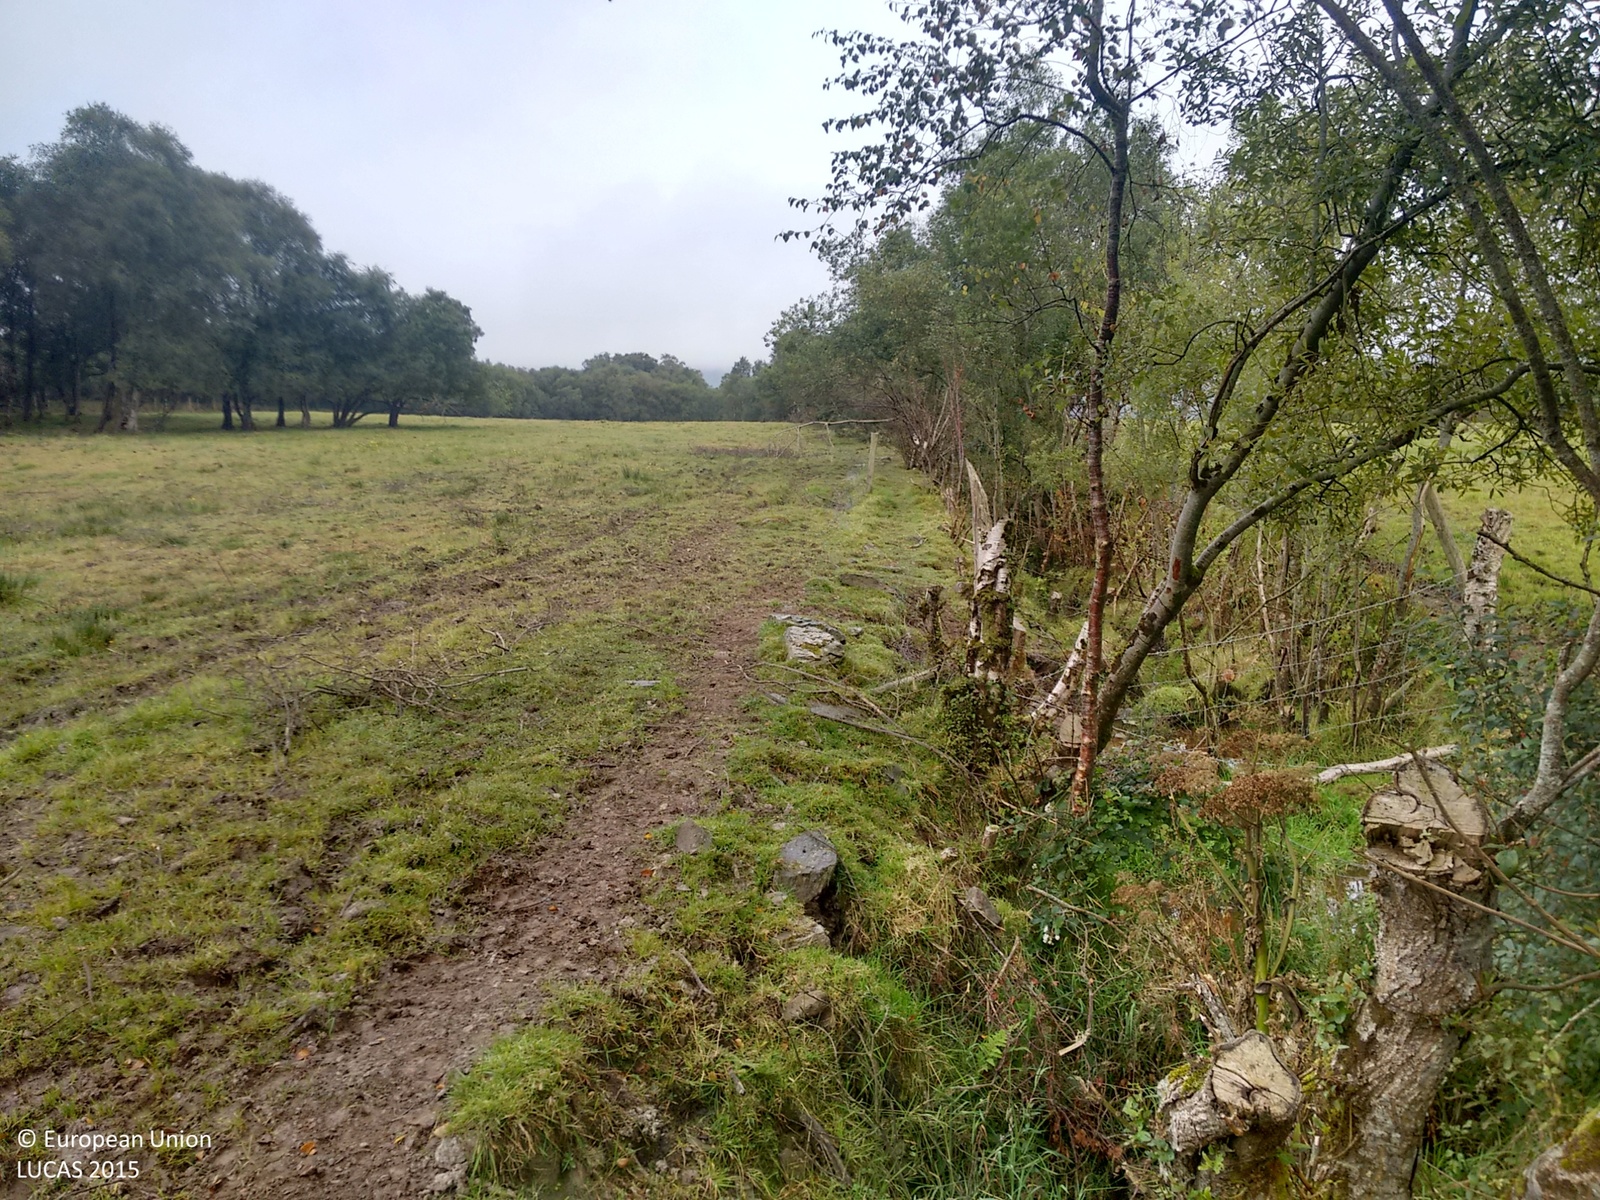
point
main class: Grassland
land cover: Grassland without tree/shrub cover
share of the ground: > 75 %
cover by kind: herbaceous plants 100 %
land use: Agriculture (excluding fallow land and kitchen gardens)
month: September
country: IE
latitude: 55.0729
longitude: -7.2964
